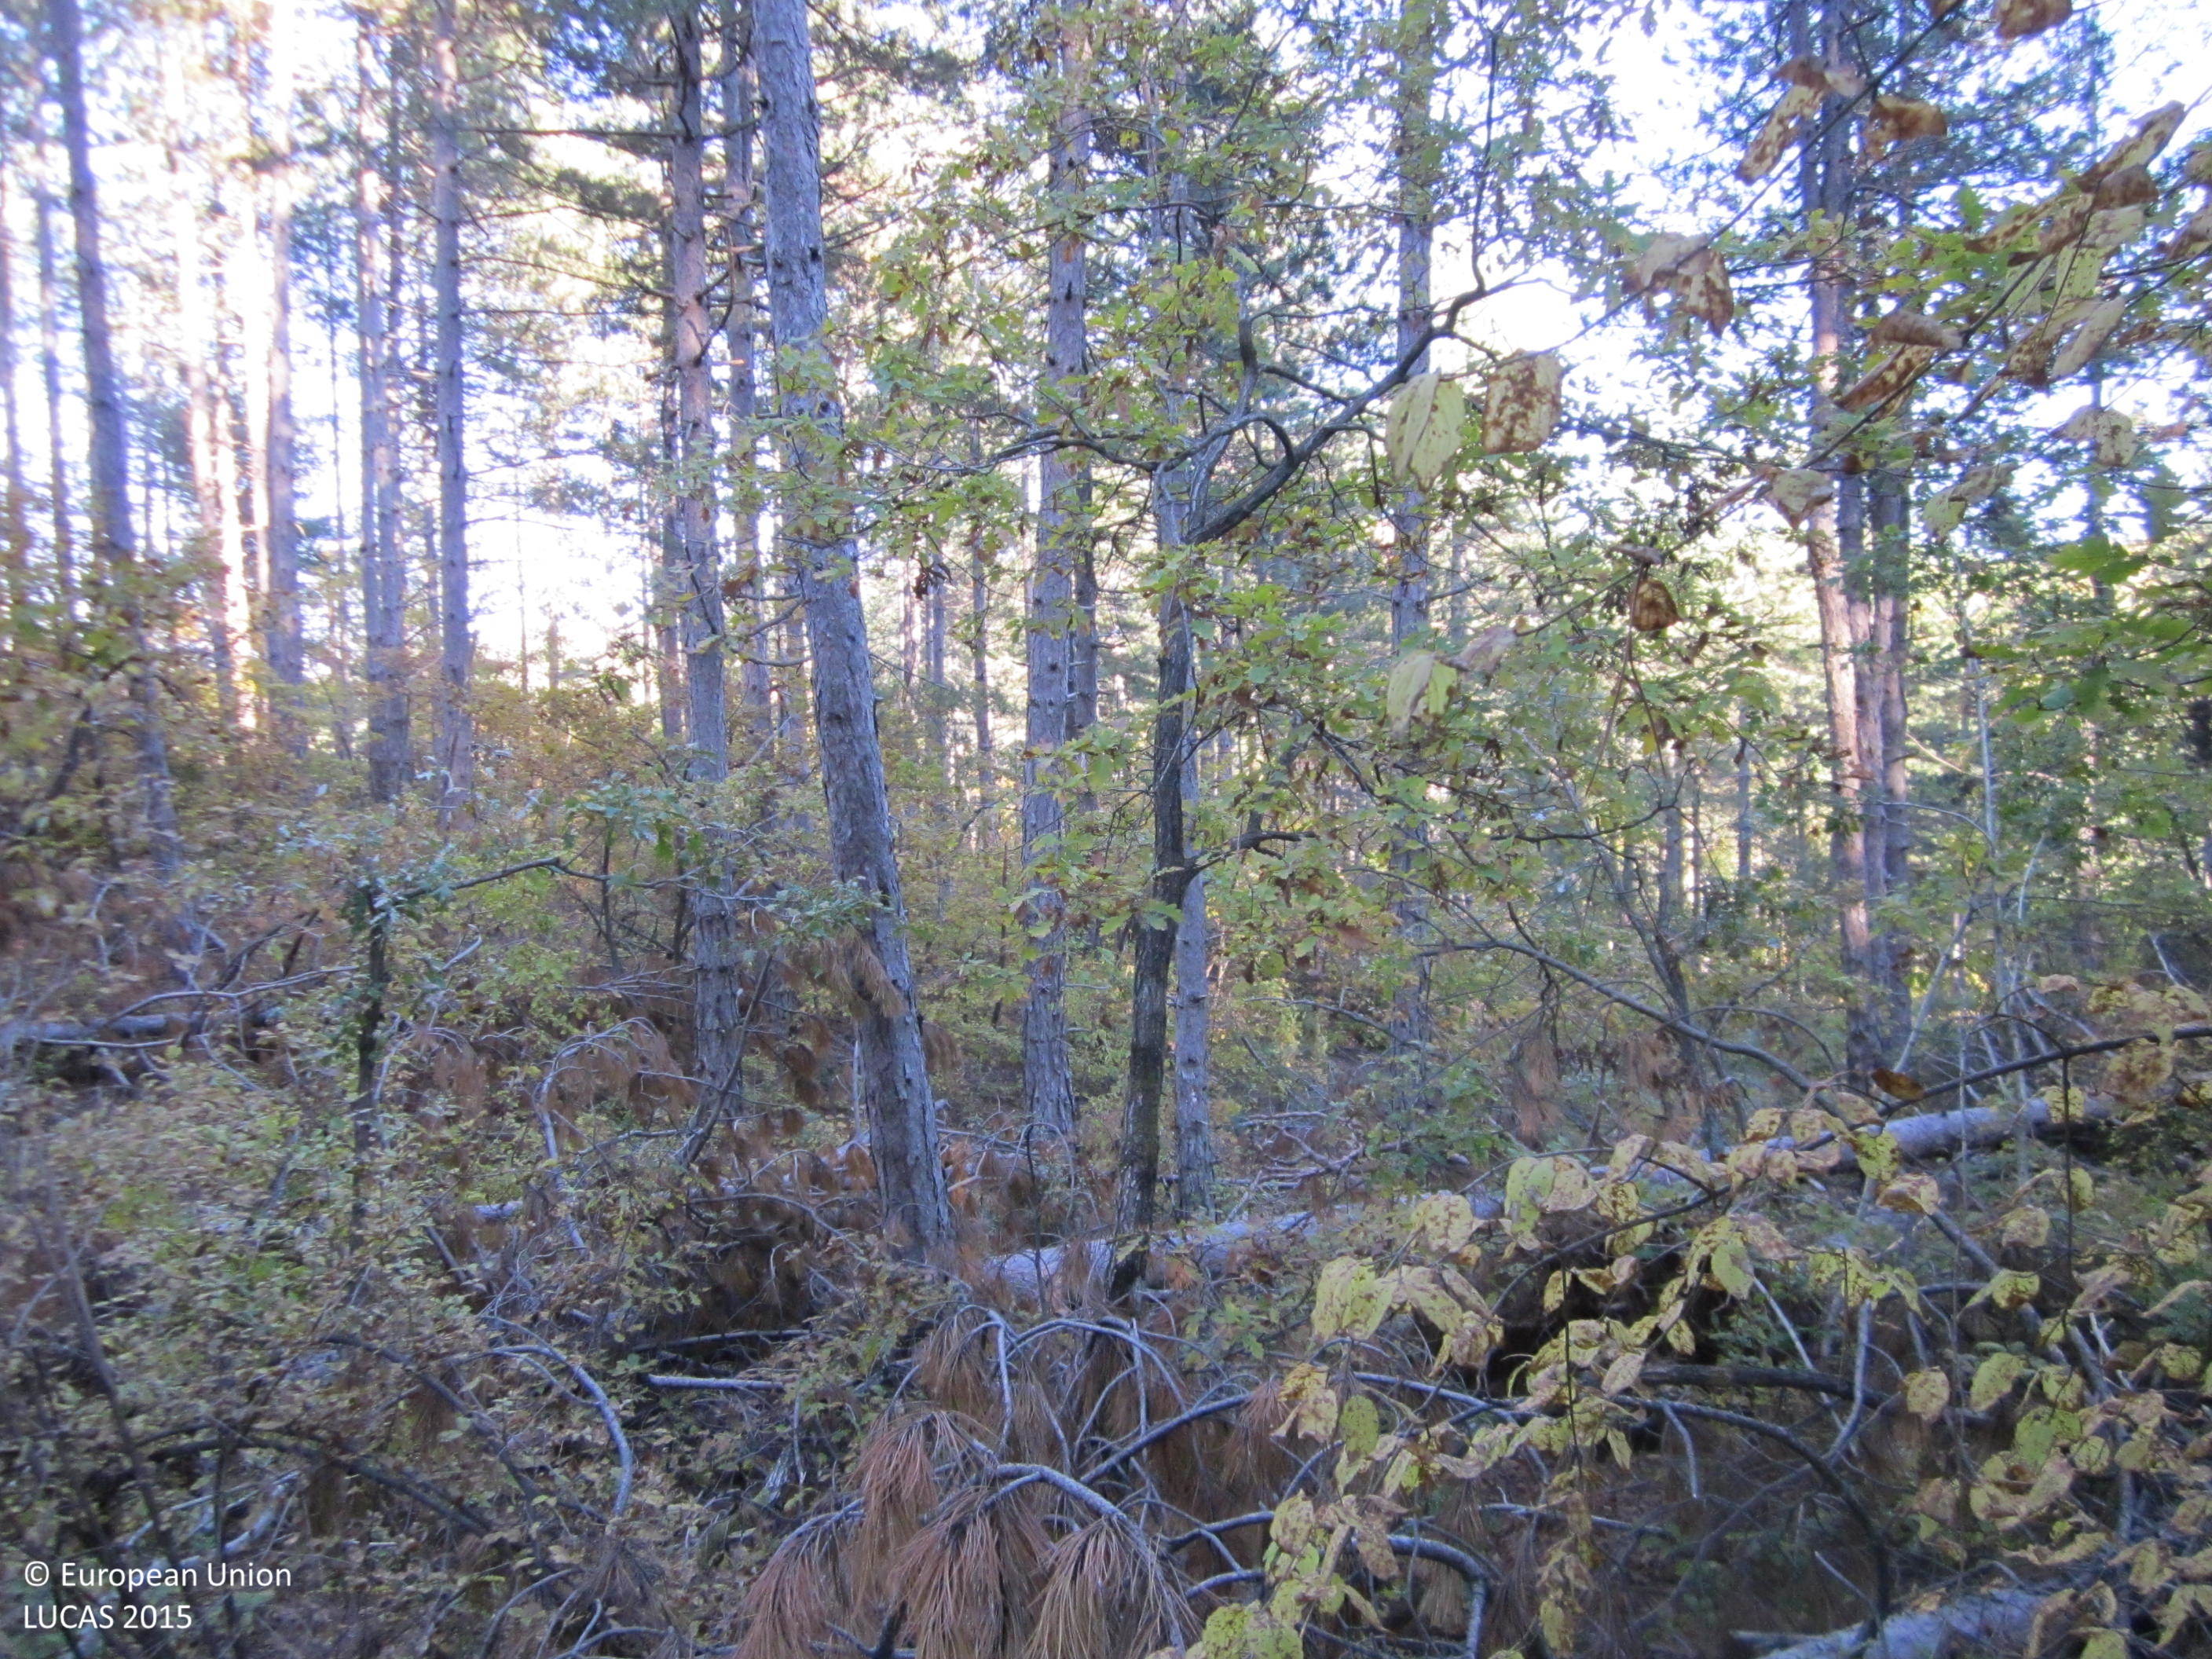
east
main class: Woodland
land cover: Pine dominated coniferous woodland
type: hemiboreal forest and nemoral coniferous forest and mixed broadleaved-coniferous forest
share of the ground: > 75 %
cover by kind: coniferous forest trees 60 %, broadleaved forest trees 20 %, unconsolidated bare surface 15 %, shrubs 5 %
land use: Forestry
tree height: > 5 m
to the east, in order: Pine dominated coniferous woodland; Tracks; Pine dominated coniferous woodland
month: November
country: BG
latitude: 41.3707
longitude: 25.7832
